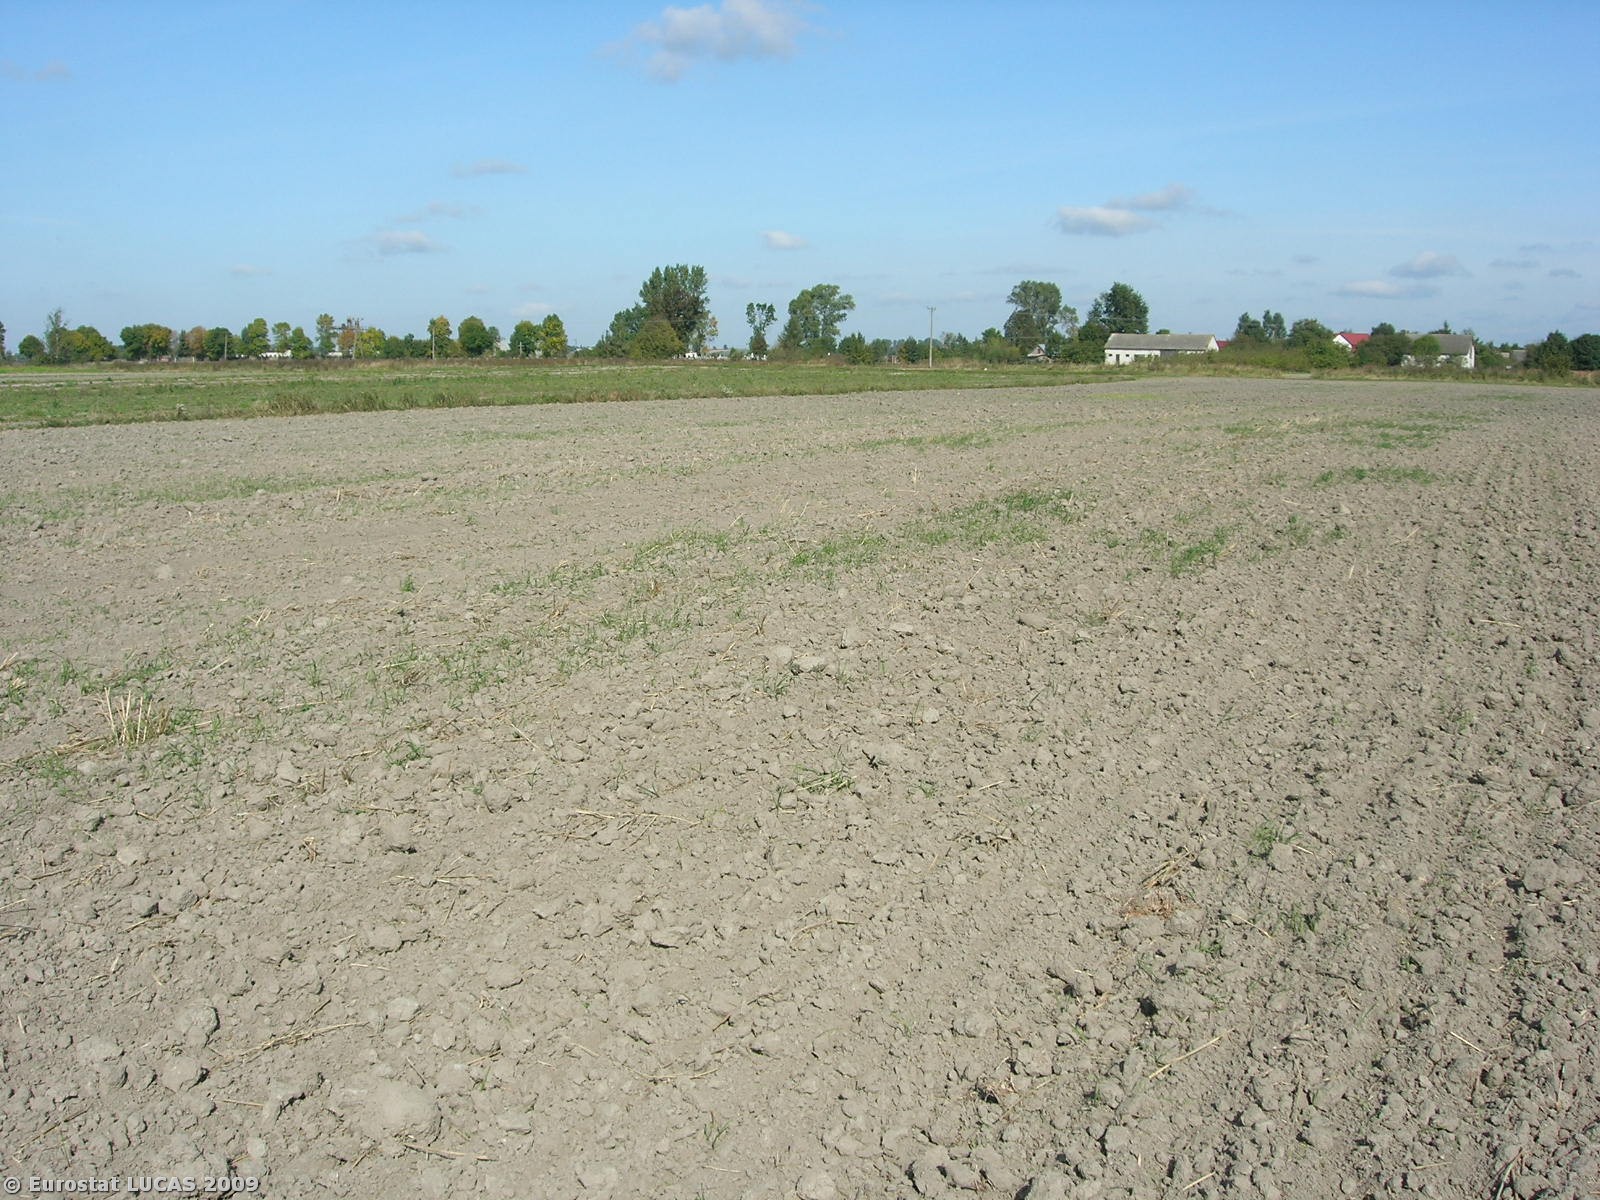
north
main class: Cropland
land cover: Rape and turnip rape
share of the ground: < 10 %
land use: Agriculture (excluding fallow land and kitchen gardens)
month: September
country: PL
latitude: 50.4186
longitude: 23.7832
